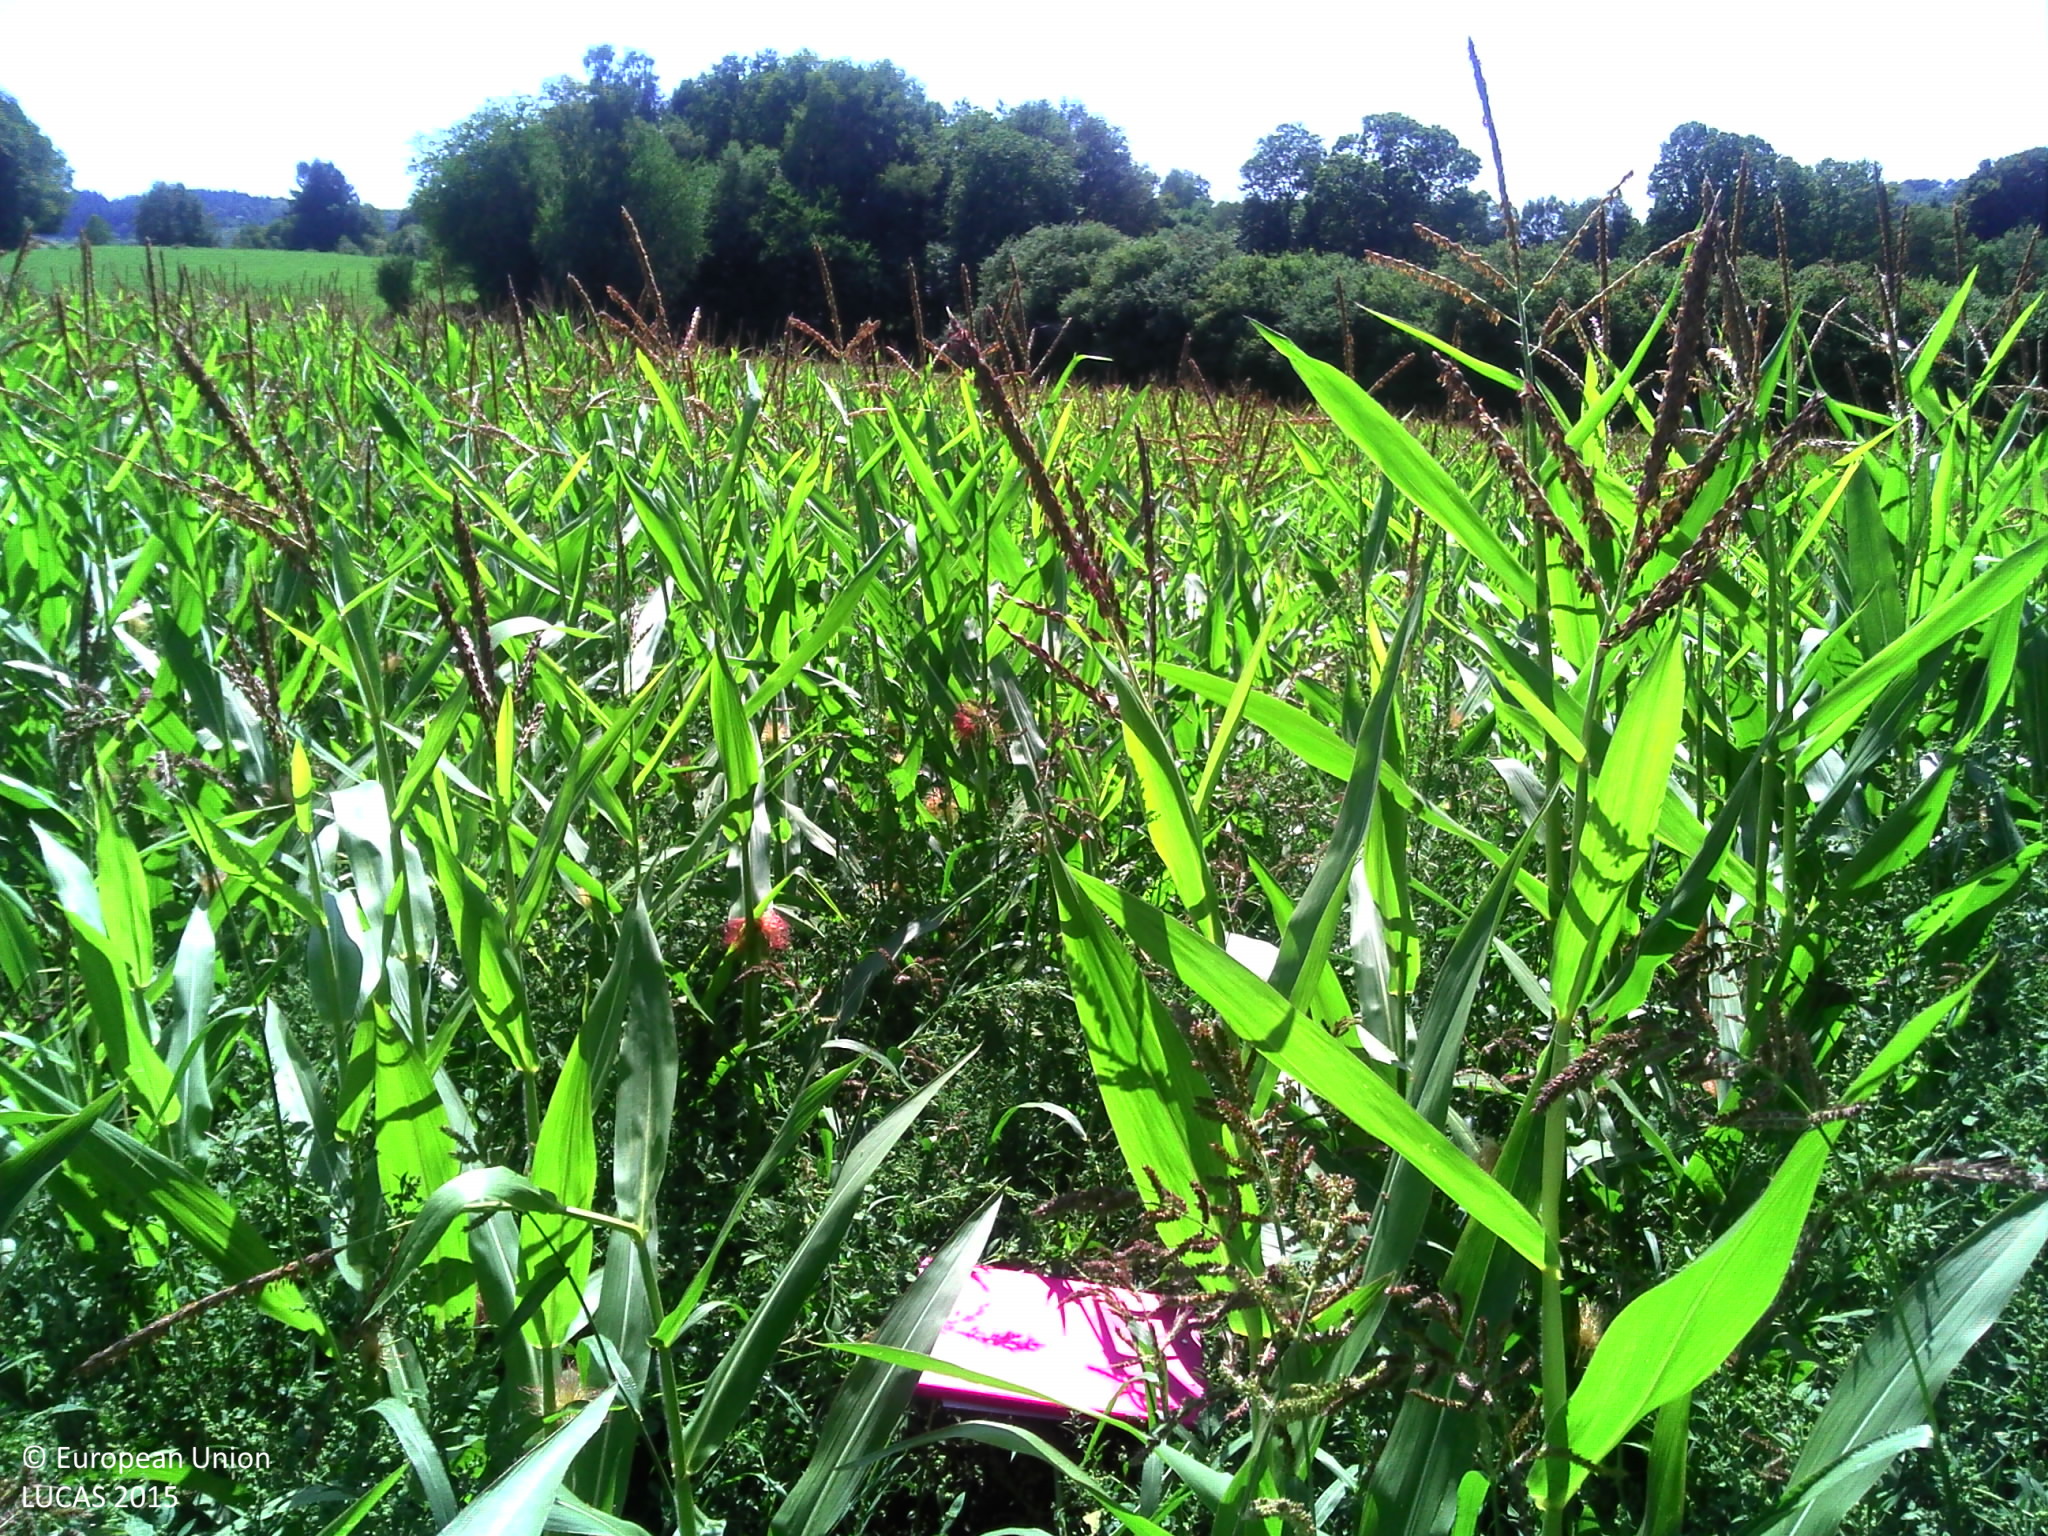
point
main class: Cropland
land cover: Maize
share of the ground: 50 - 75 %
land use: Agriculture (excluding fallow land and kitchen gardens)
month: August
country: FR
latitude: 45.8661
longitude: 1.7106
